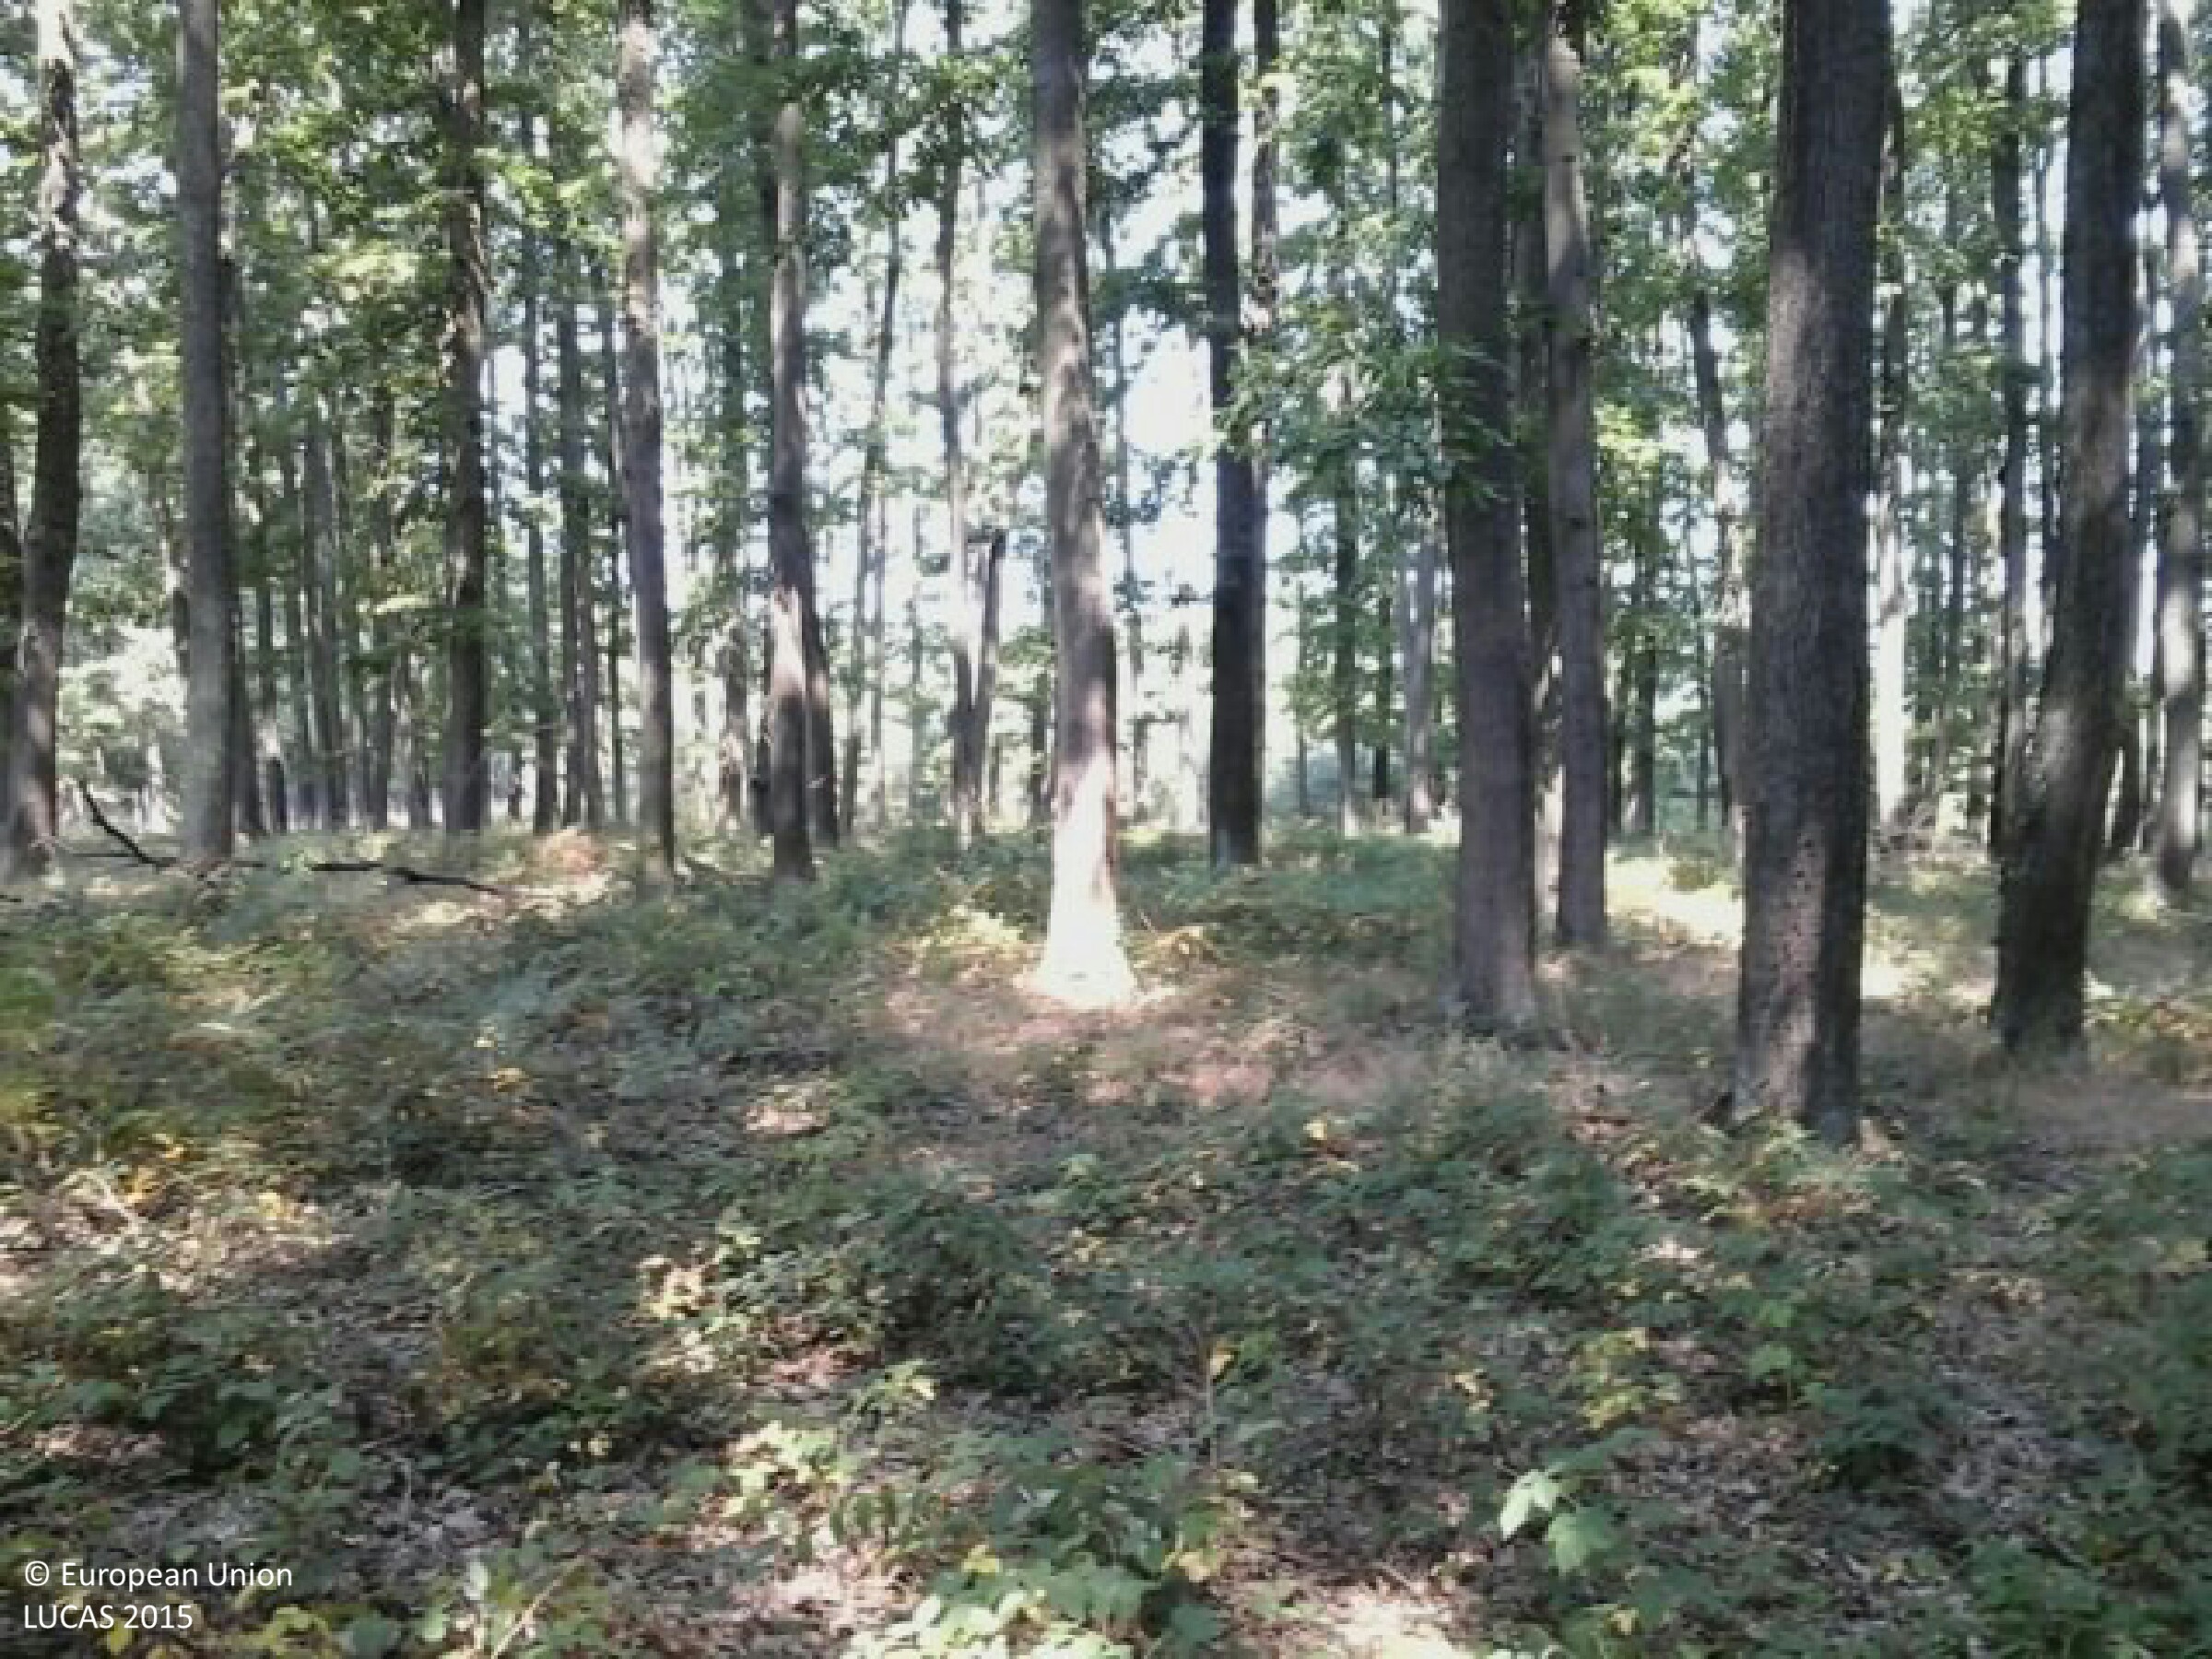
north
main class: Woodland
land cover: Broadleaved woodland
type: mesophytic deciduous forest
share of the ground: > 75 %
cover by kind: broadleaved forest trees 95 %, shrubs 5 %
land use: Forestry
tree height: > 5 m
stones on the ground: < 10 %
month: August
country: HU
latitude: 46.1957
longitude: 17.2465
